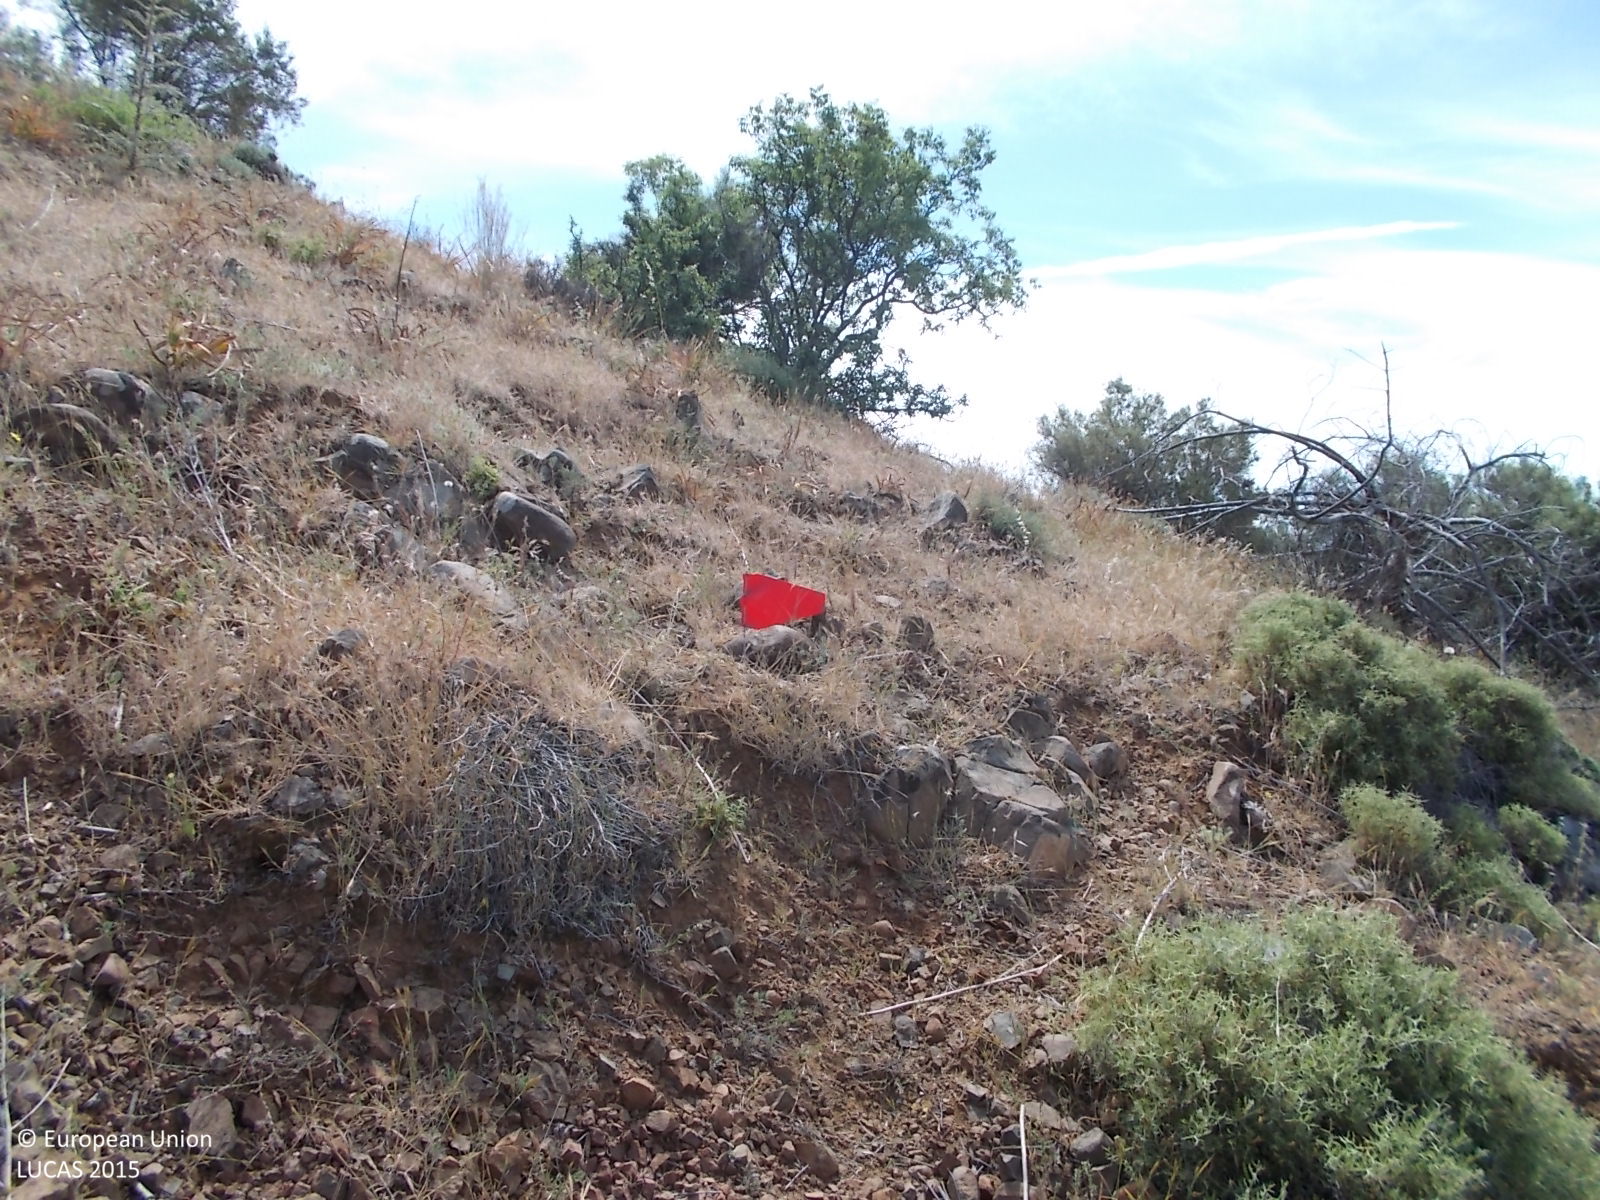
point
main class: Shrubland
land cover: Shrubland with sparse tree cover
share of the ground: 50 - 75 %
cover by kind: shrubs 75 %, herbaceous plants 20 %, broadleaved forest trees 5 %
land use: Semi-natural and natural areas not in use
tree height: < 5 m
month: May
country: CY
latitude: 34.9199
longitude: 33.3127
